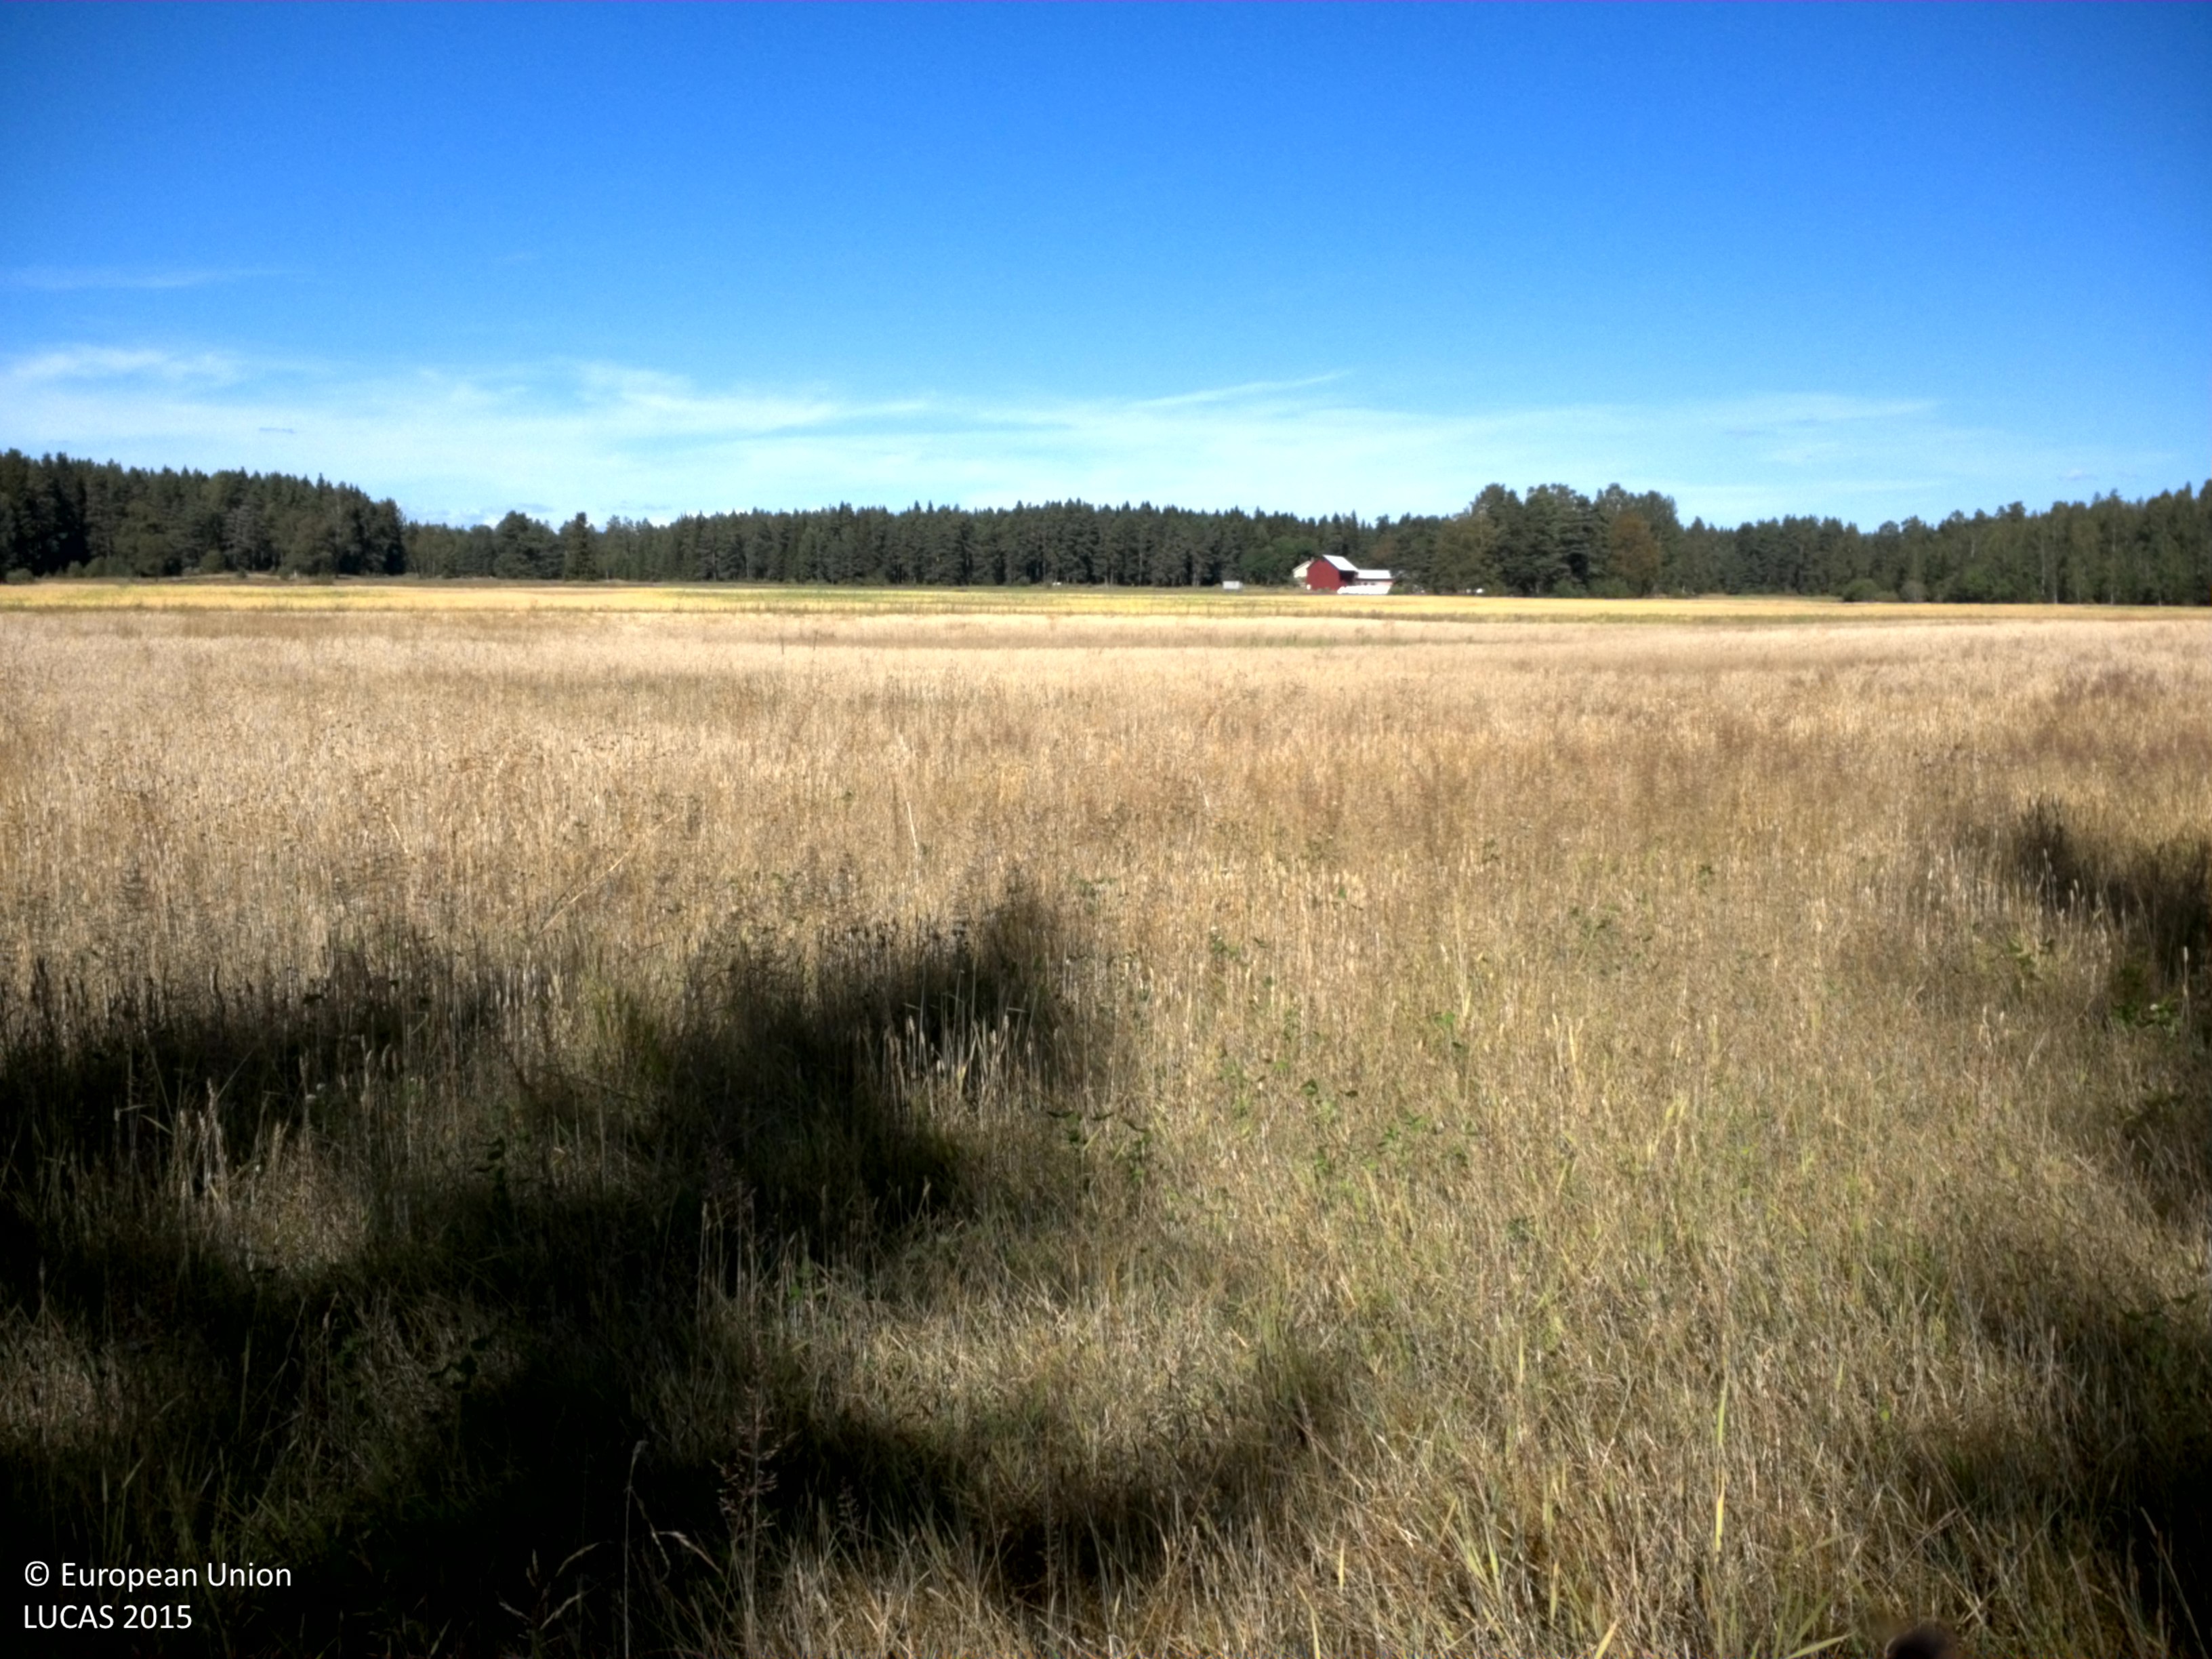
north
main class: Grassland
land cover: Grassland without tree/shrub cover
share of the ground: > 75 %
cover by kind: herbaceous plants 100 %
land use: Agriculture (excluding fallow land and kitchen gardens)
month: August
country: SE
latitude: 60.1158
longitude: 16.9905
